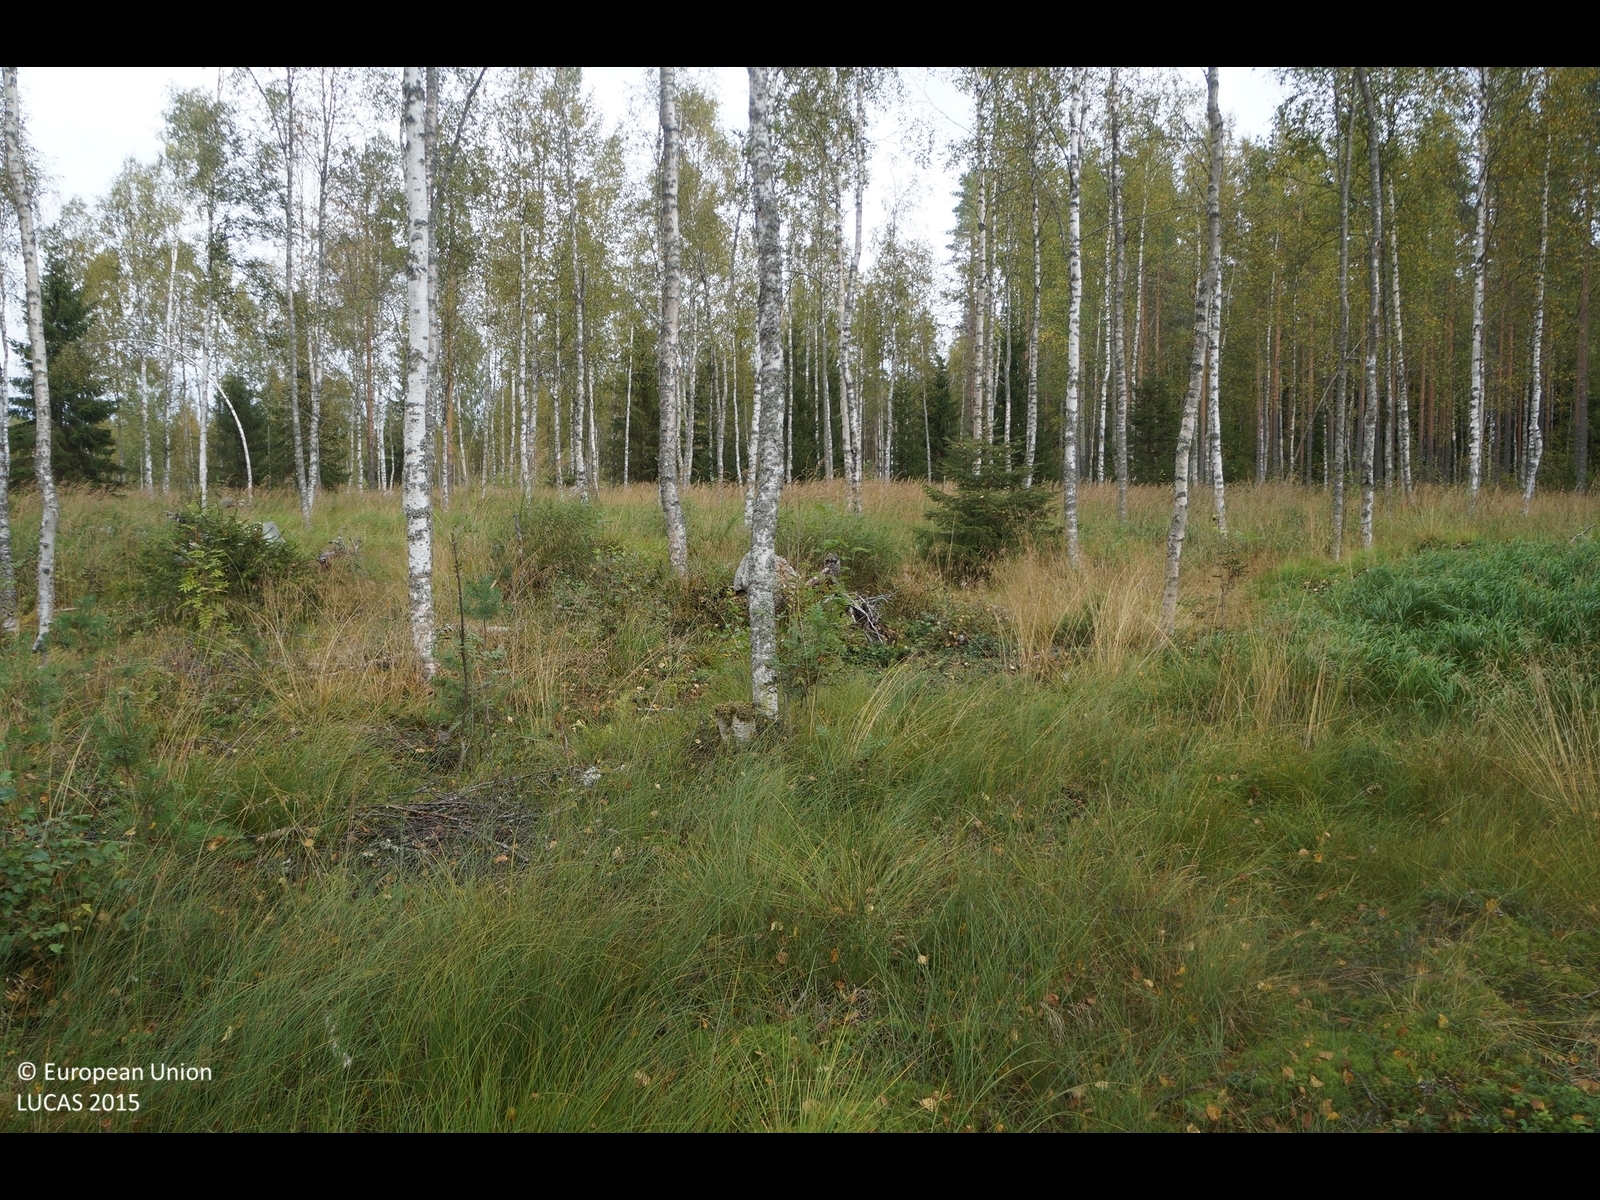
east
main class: Woodland
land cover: Broadleaved woodland
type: non-riverine alder, birch or aspen forest
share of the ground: 50 - 75 %
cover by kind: broadleaved forest trees 50 %, shrubs 20 %, herbaceous plants 20 %, lichens and mosses 10 %
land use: Forestry
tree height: > 5 m
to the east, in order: Broadleaved woodland; Ditches and canals; Broadleaved woodland; Ditches and canals; Broadleaved woodland; Ditches and canals; Shrubland with sparse tree cover; Ditches and canals; Shrubland with sparse tree cover; Ditches and canals; Grassland with sparse tree/shrub cover; Ditches and canals; Shrubland with sparse tree cover; Ditches and canals; Shruby margins; Tracks; Shruby margins; Ditches and canals; Broadleaved woodland; Pine dominated mixed woodland
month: September
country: FI
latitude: 64.0370
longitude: 24.3408
